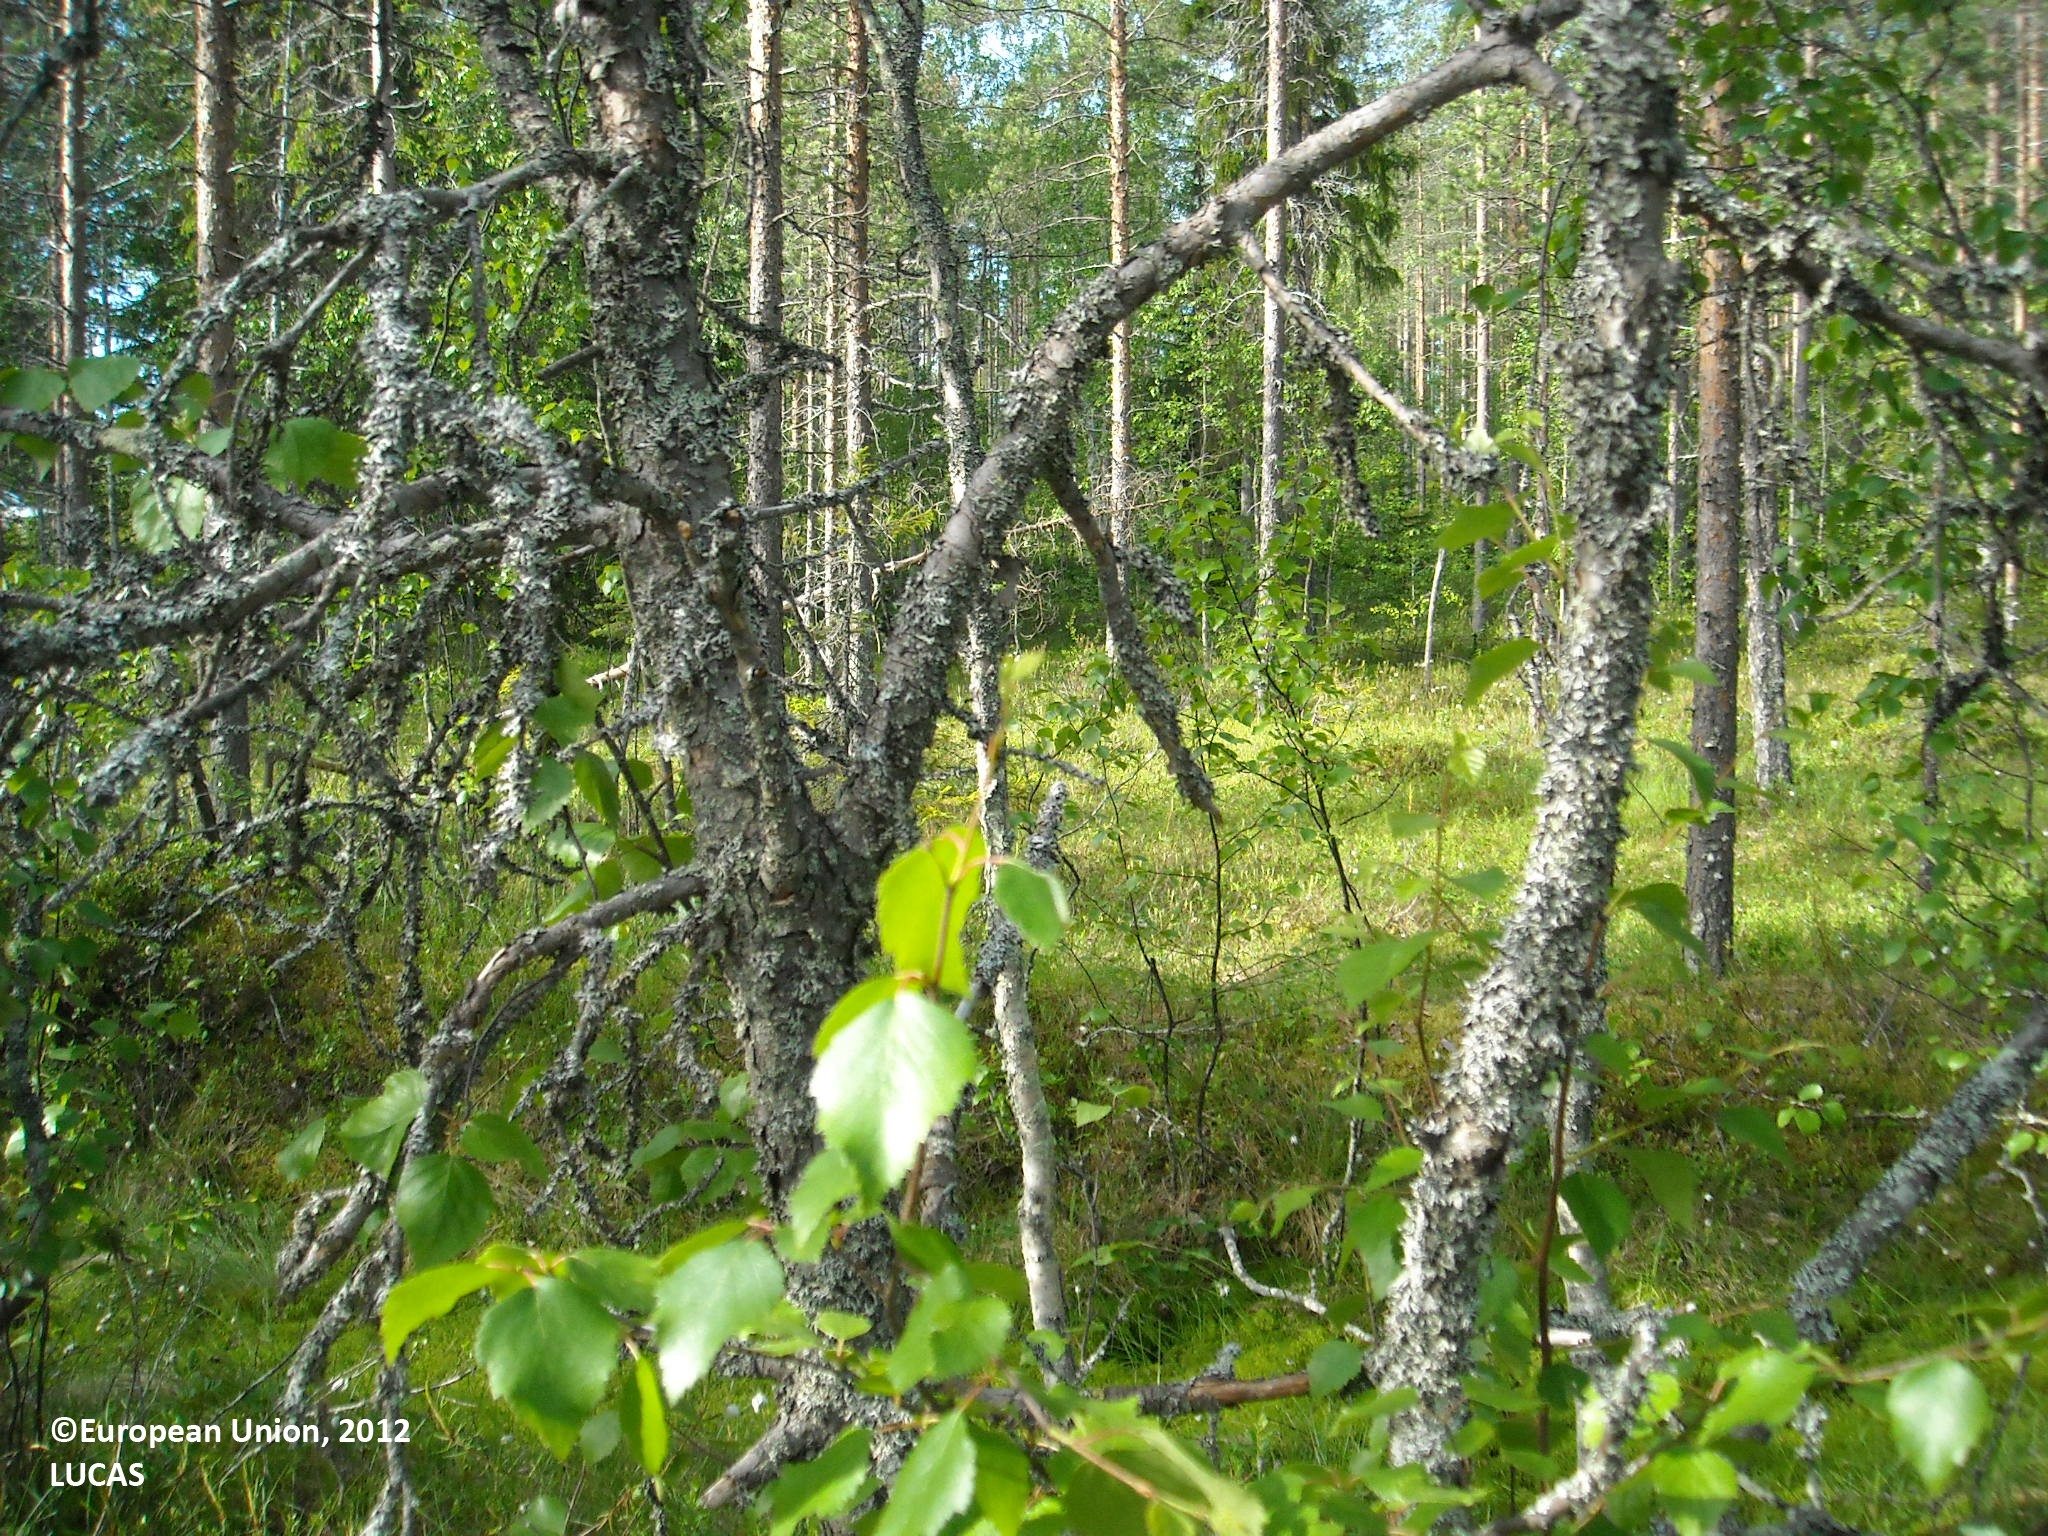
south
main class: Woodland
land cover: Pine dominated coniferous woodland
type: mire and swamp forests
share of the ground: > 75 %
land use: Forestry
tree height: > 5 m
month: July
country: FI
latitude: 64.6505
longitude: 27.7542
